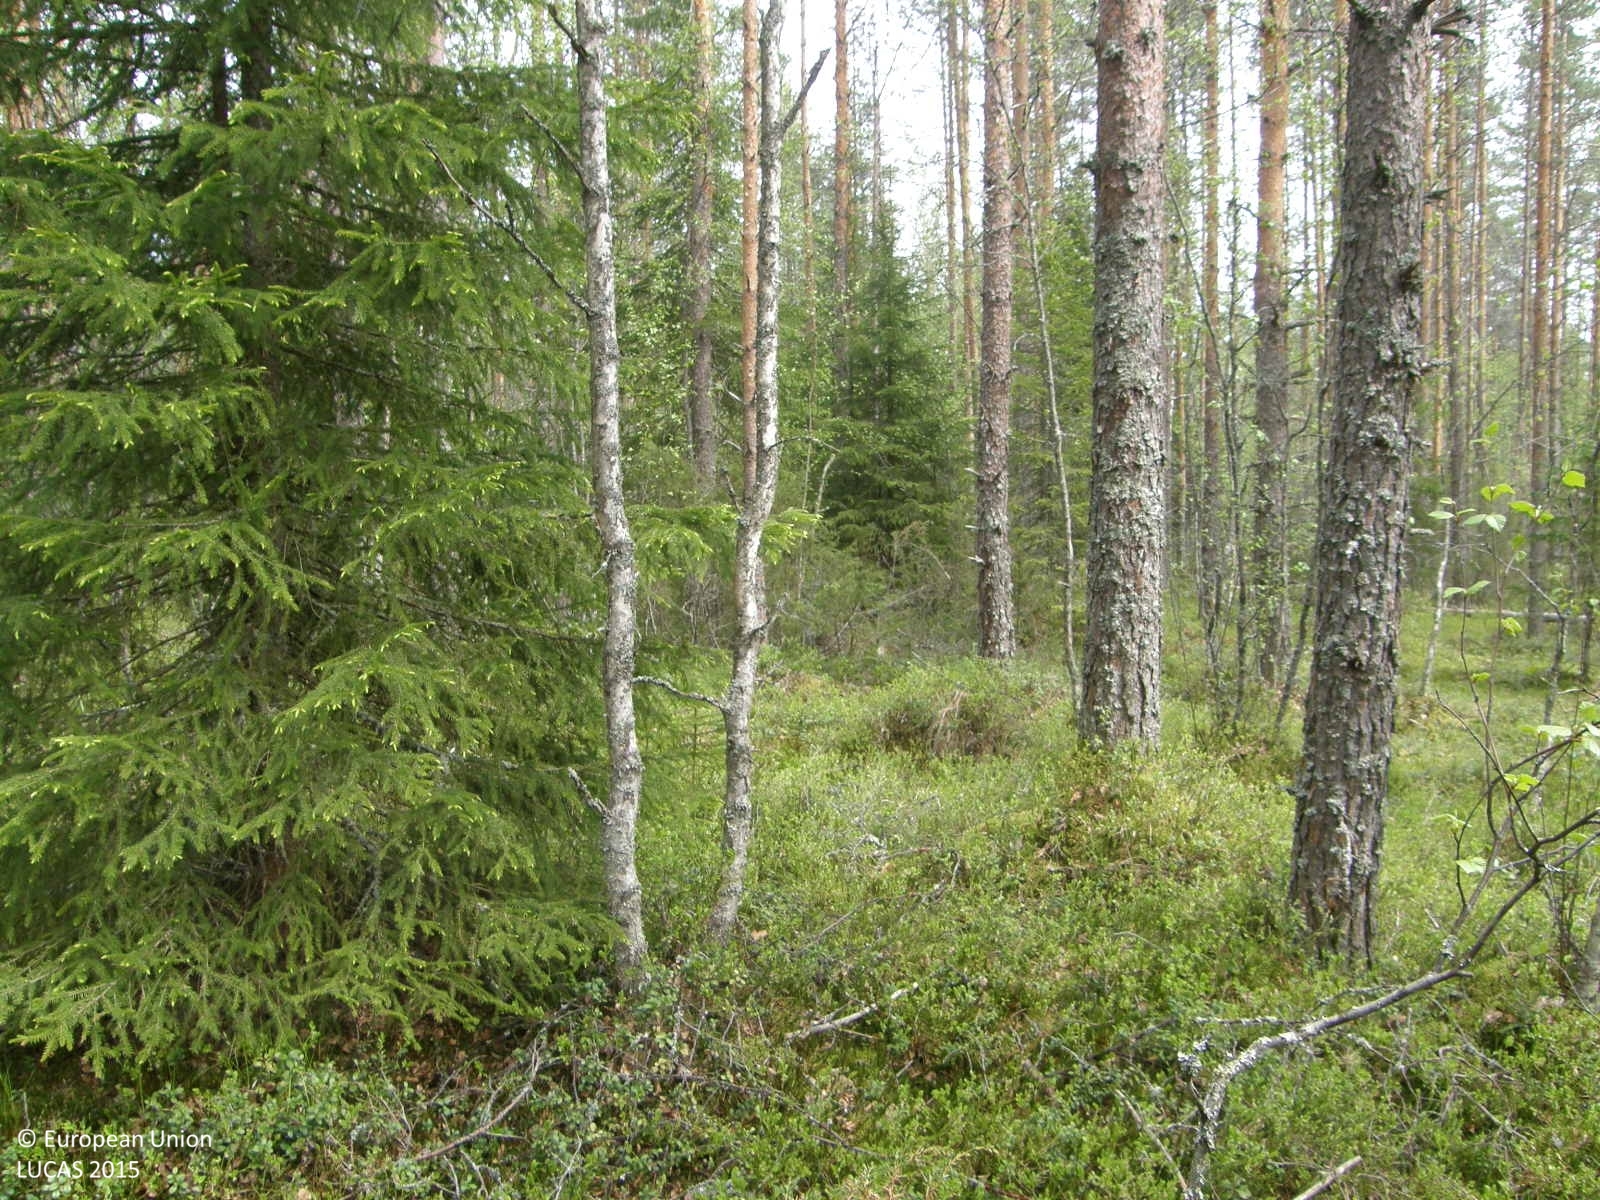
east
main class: Woodland
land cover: Pine dominated mixed woodland
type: boreal forest
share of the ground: > 75 %
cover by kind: coniferous forest trees 65 %, broadleaved forest trees 25 %, shrubs 10 %
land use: Forestry
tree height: > 5 m
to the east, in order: Pine dominated mixed woodland; Ditches and canals; Pine dominated mixed woodland; Ditches and canals; Pine dominated mixed woodland; Spruce dominated mixed woodland
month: June
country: FI
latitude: 62.1028
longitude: 22.3371
